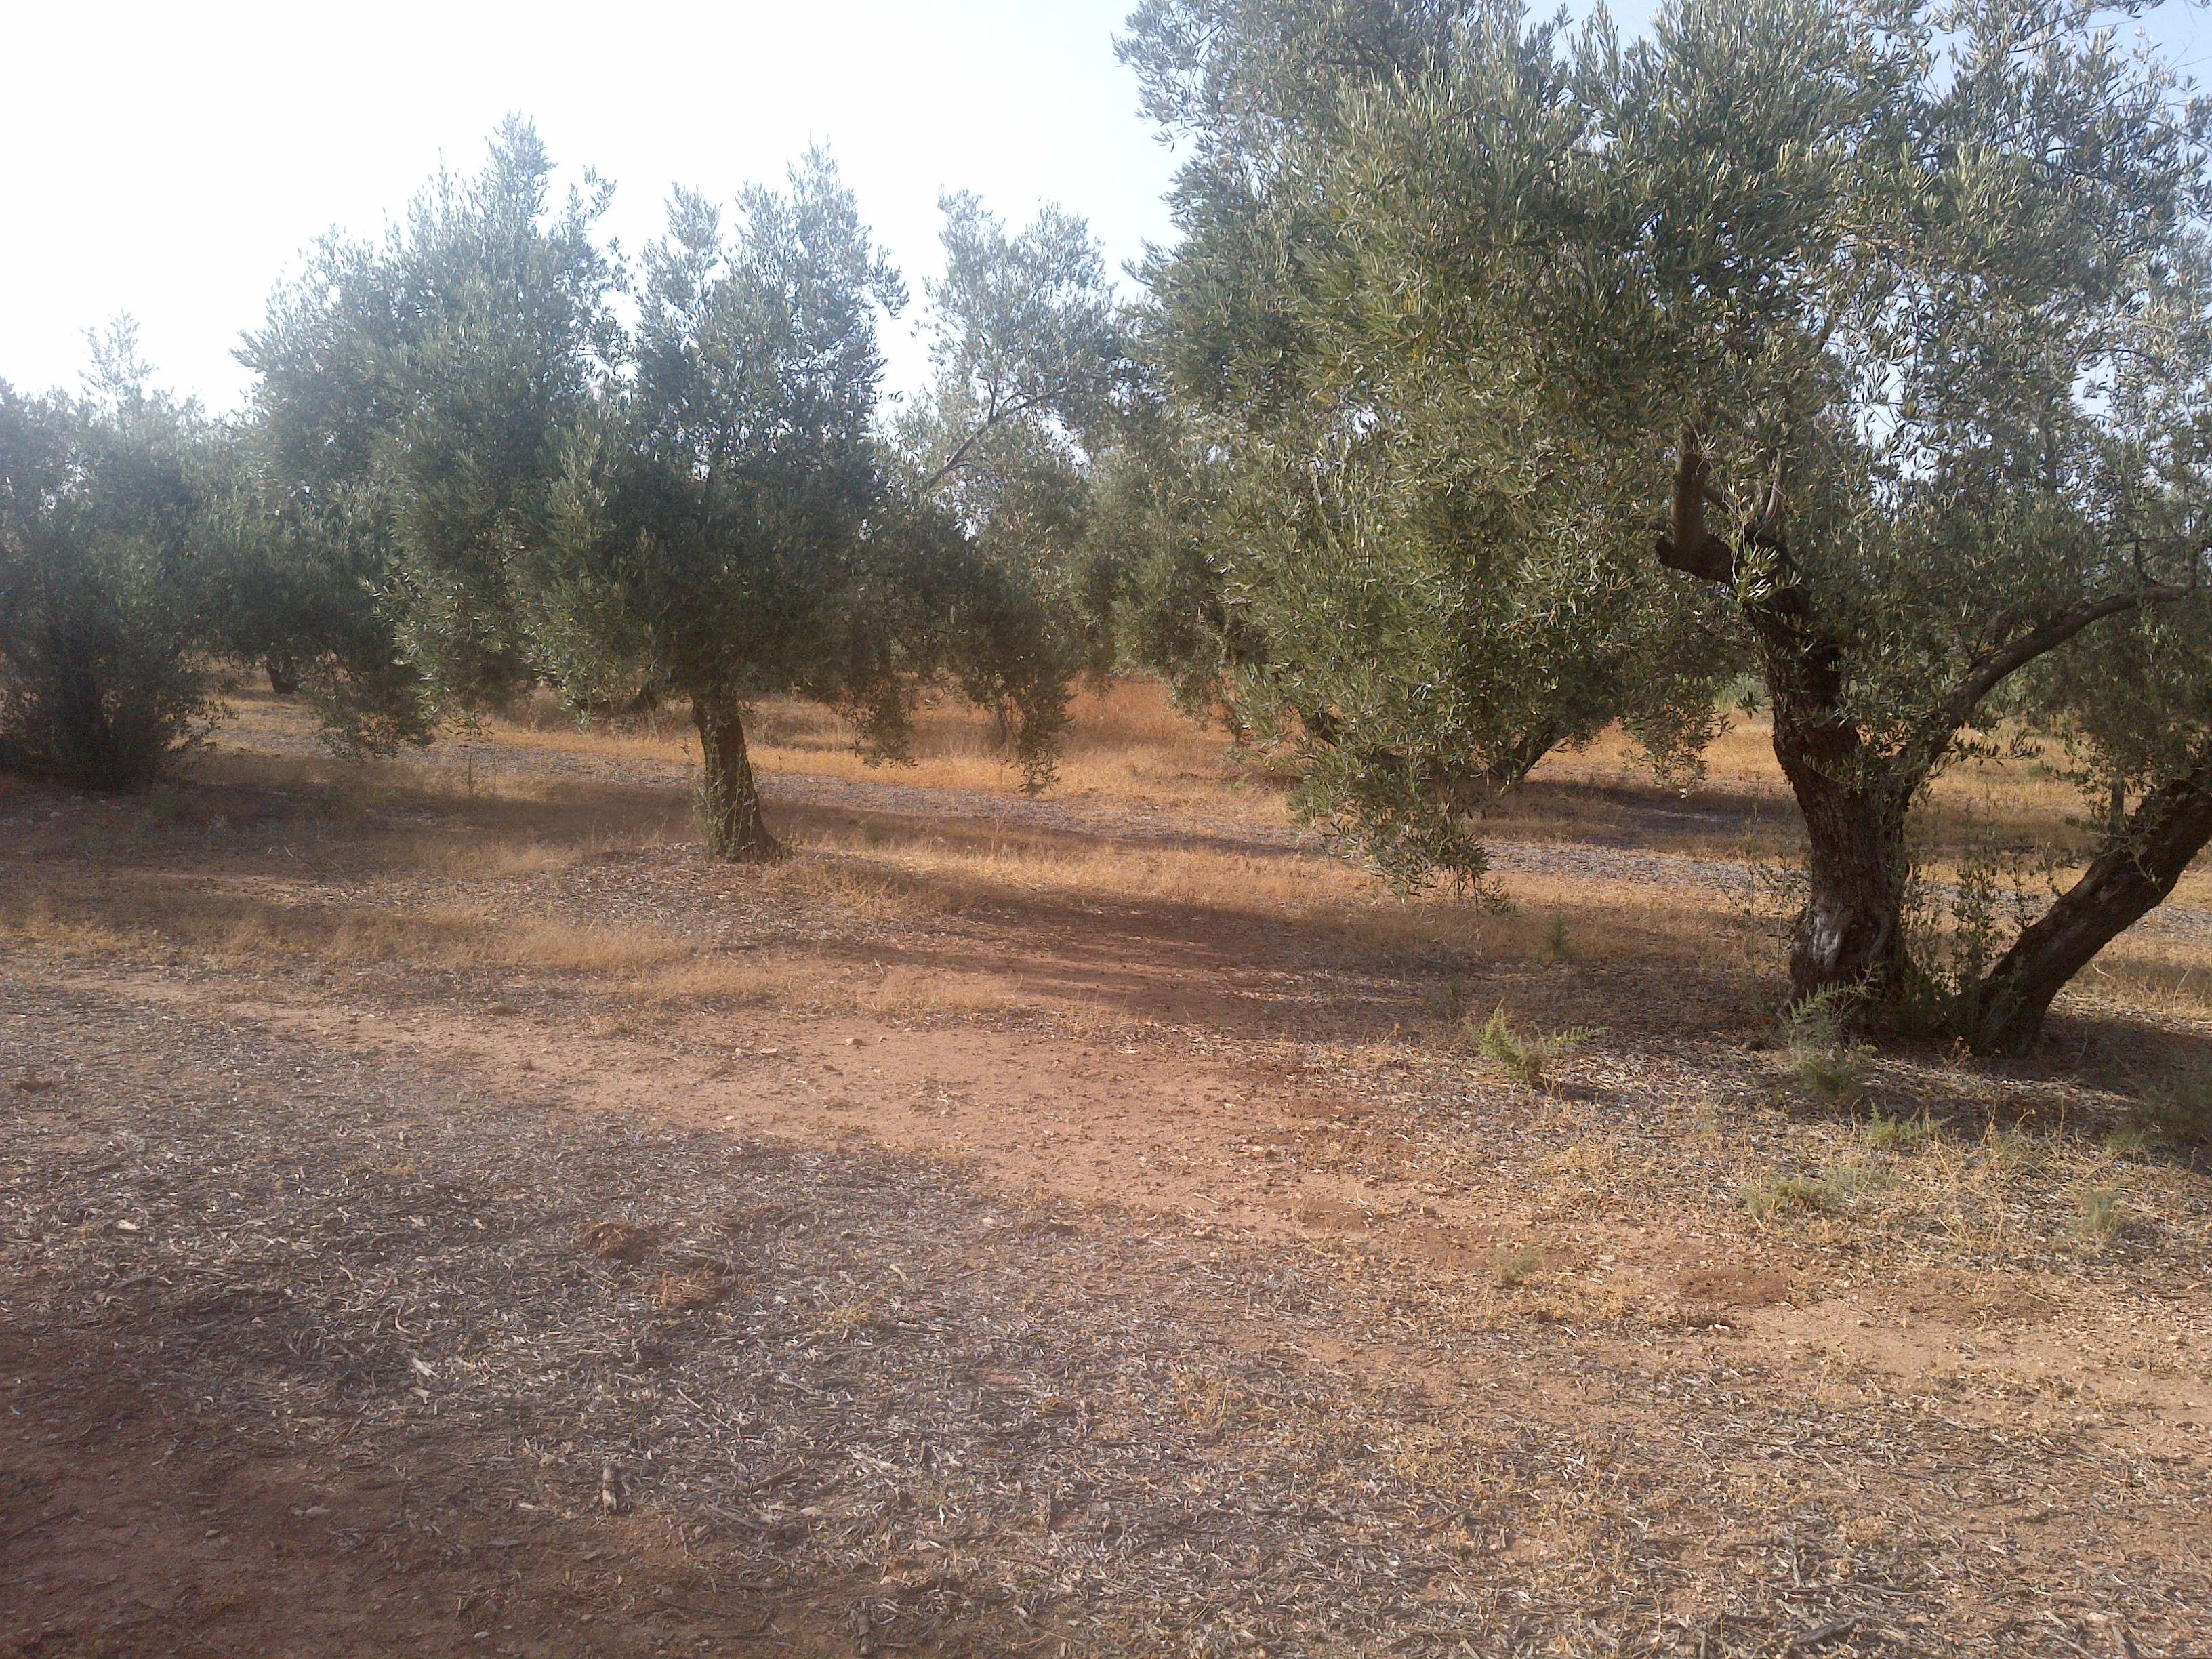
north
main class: Cropland
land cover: Olive groves
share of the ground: 50 - 75 %
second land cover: Spontaneously vegetated surfaces
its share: 10 - 25 %
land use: Agriculture (excluding fallow land and kitchen gardens)
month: July
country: ES
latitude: 37.4717
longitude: -4.8777
